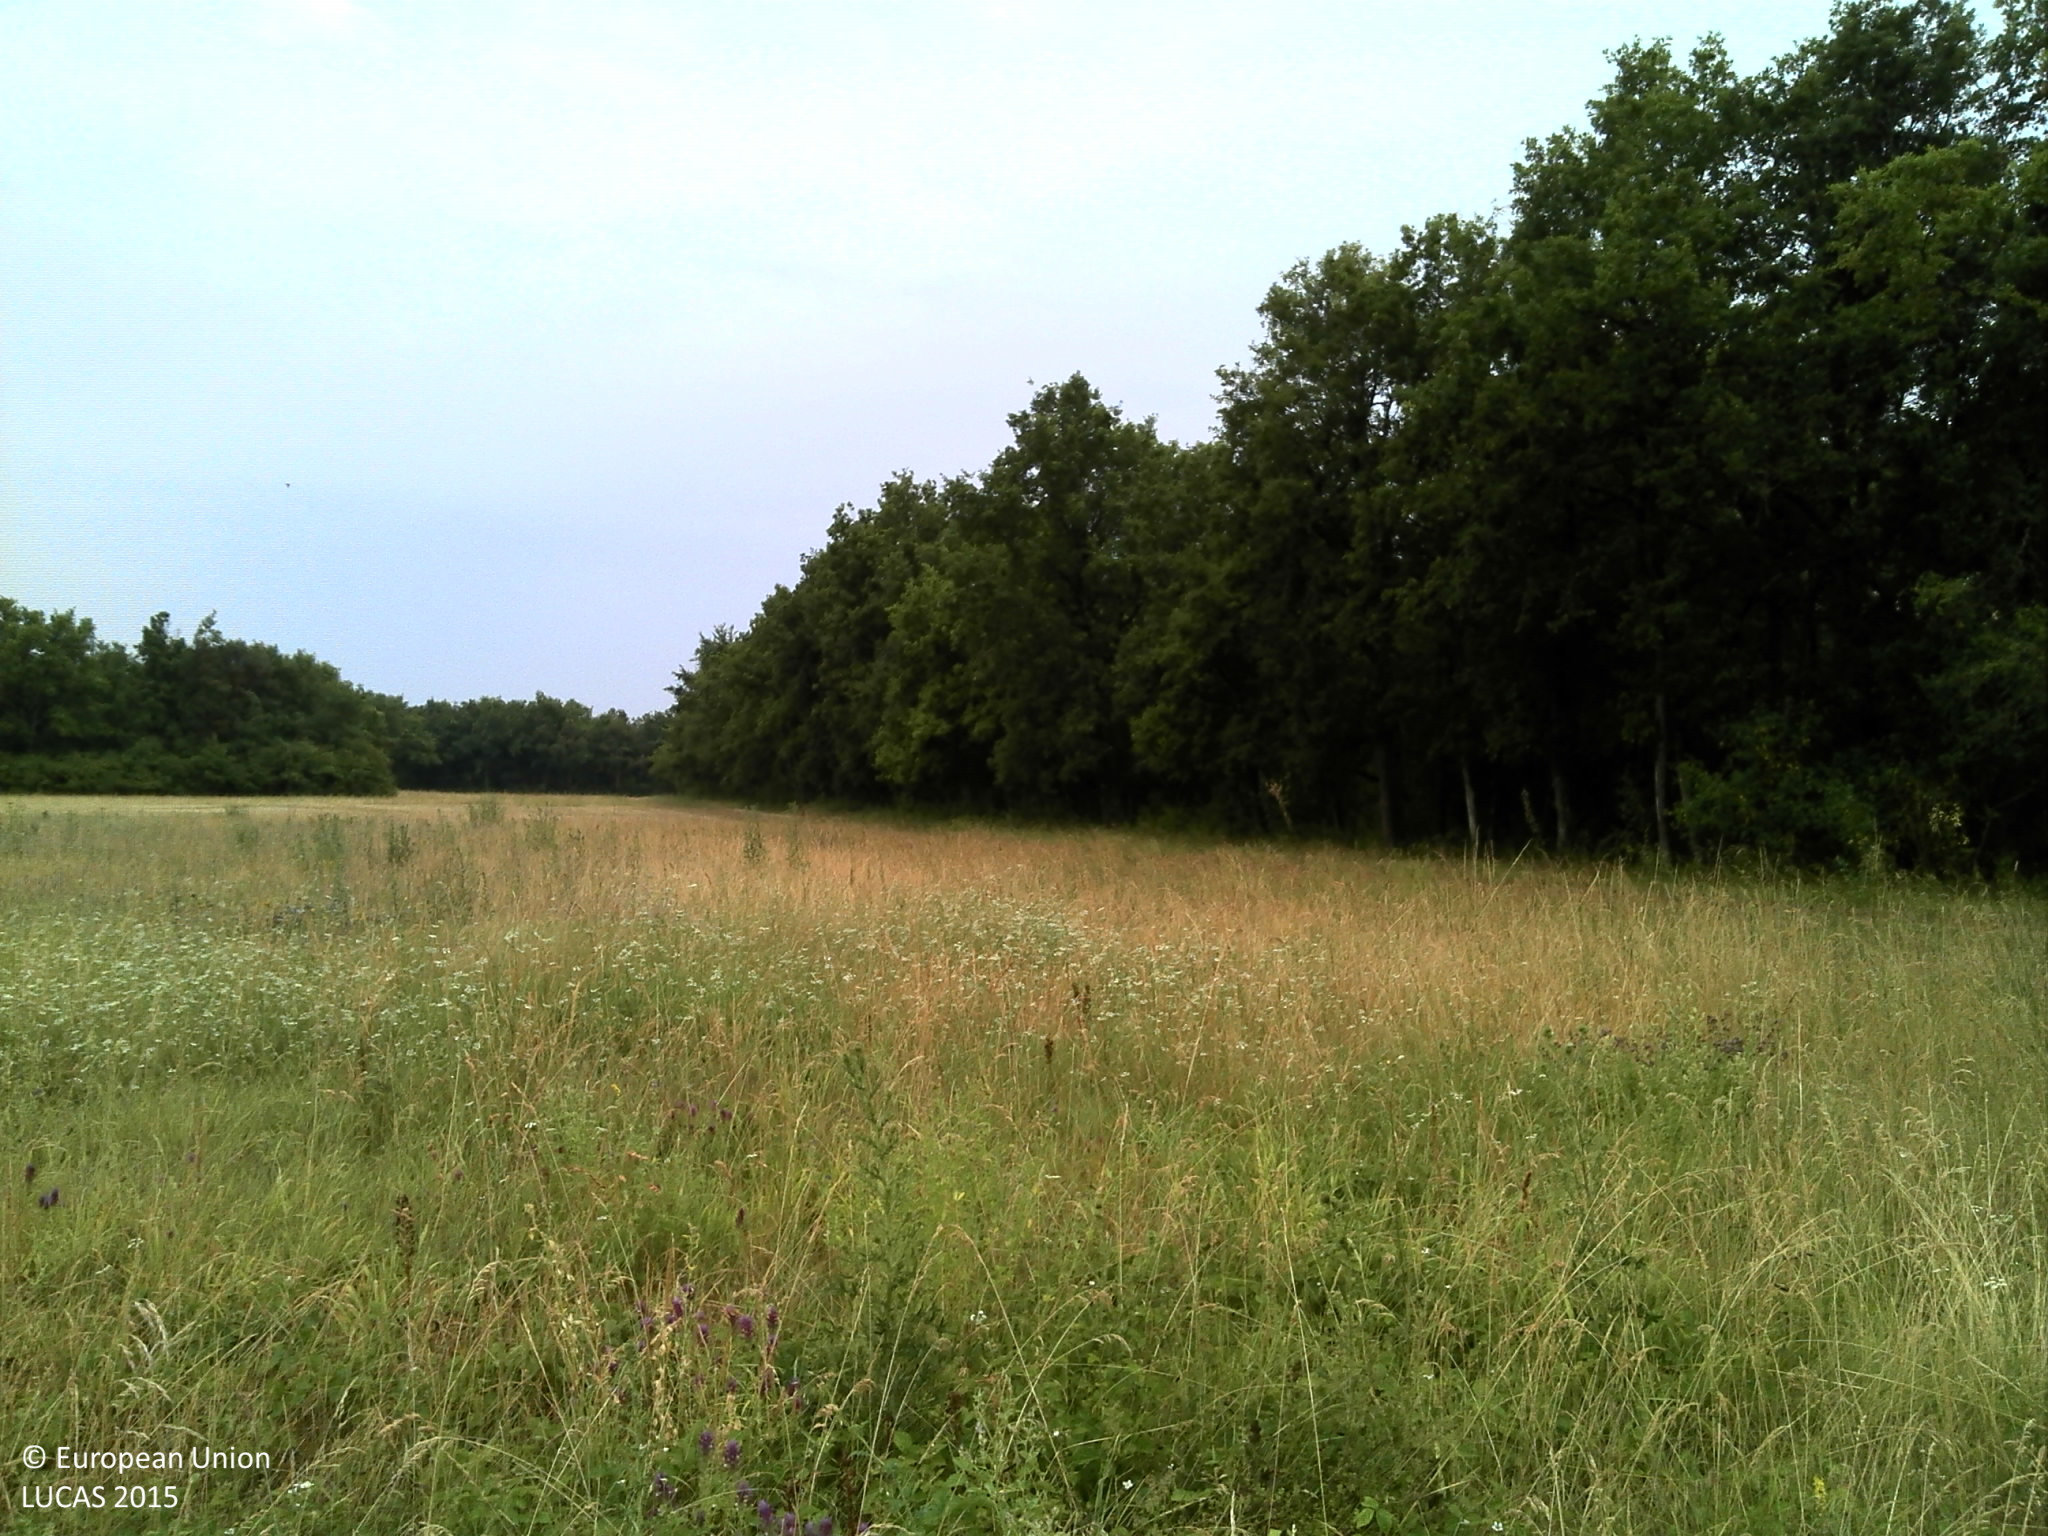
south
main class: Grassland
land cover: Grassland without tree/shrub cover
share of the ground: > 75 %
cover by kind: herbaceous plants 100 %
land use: Agriculture (excluding fallow land and kitchen gardens)
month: July
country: FR
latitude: 48.2543
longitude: 2.4606
